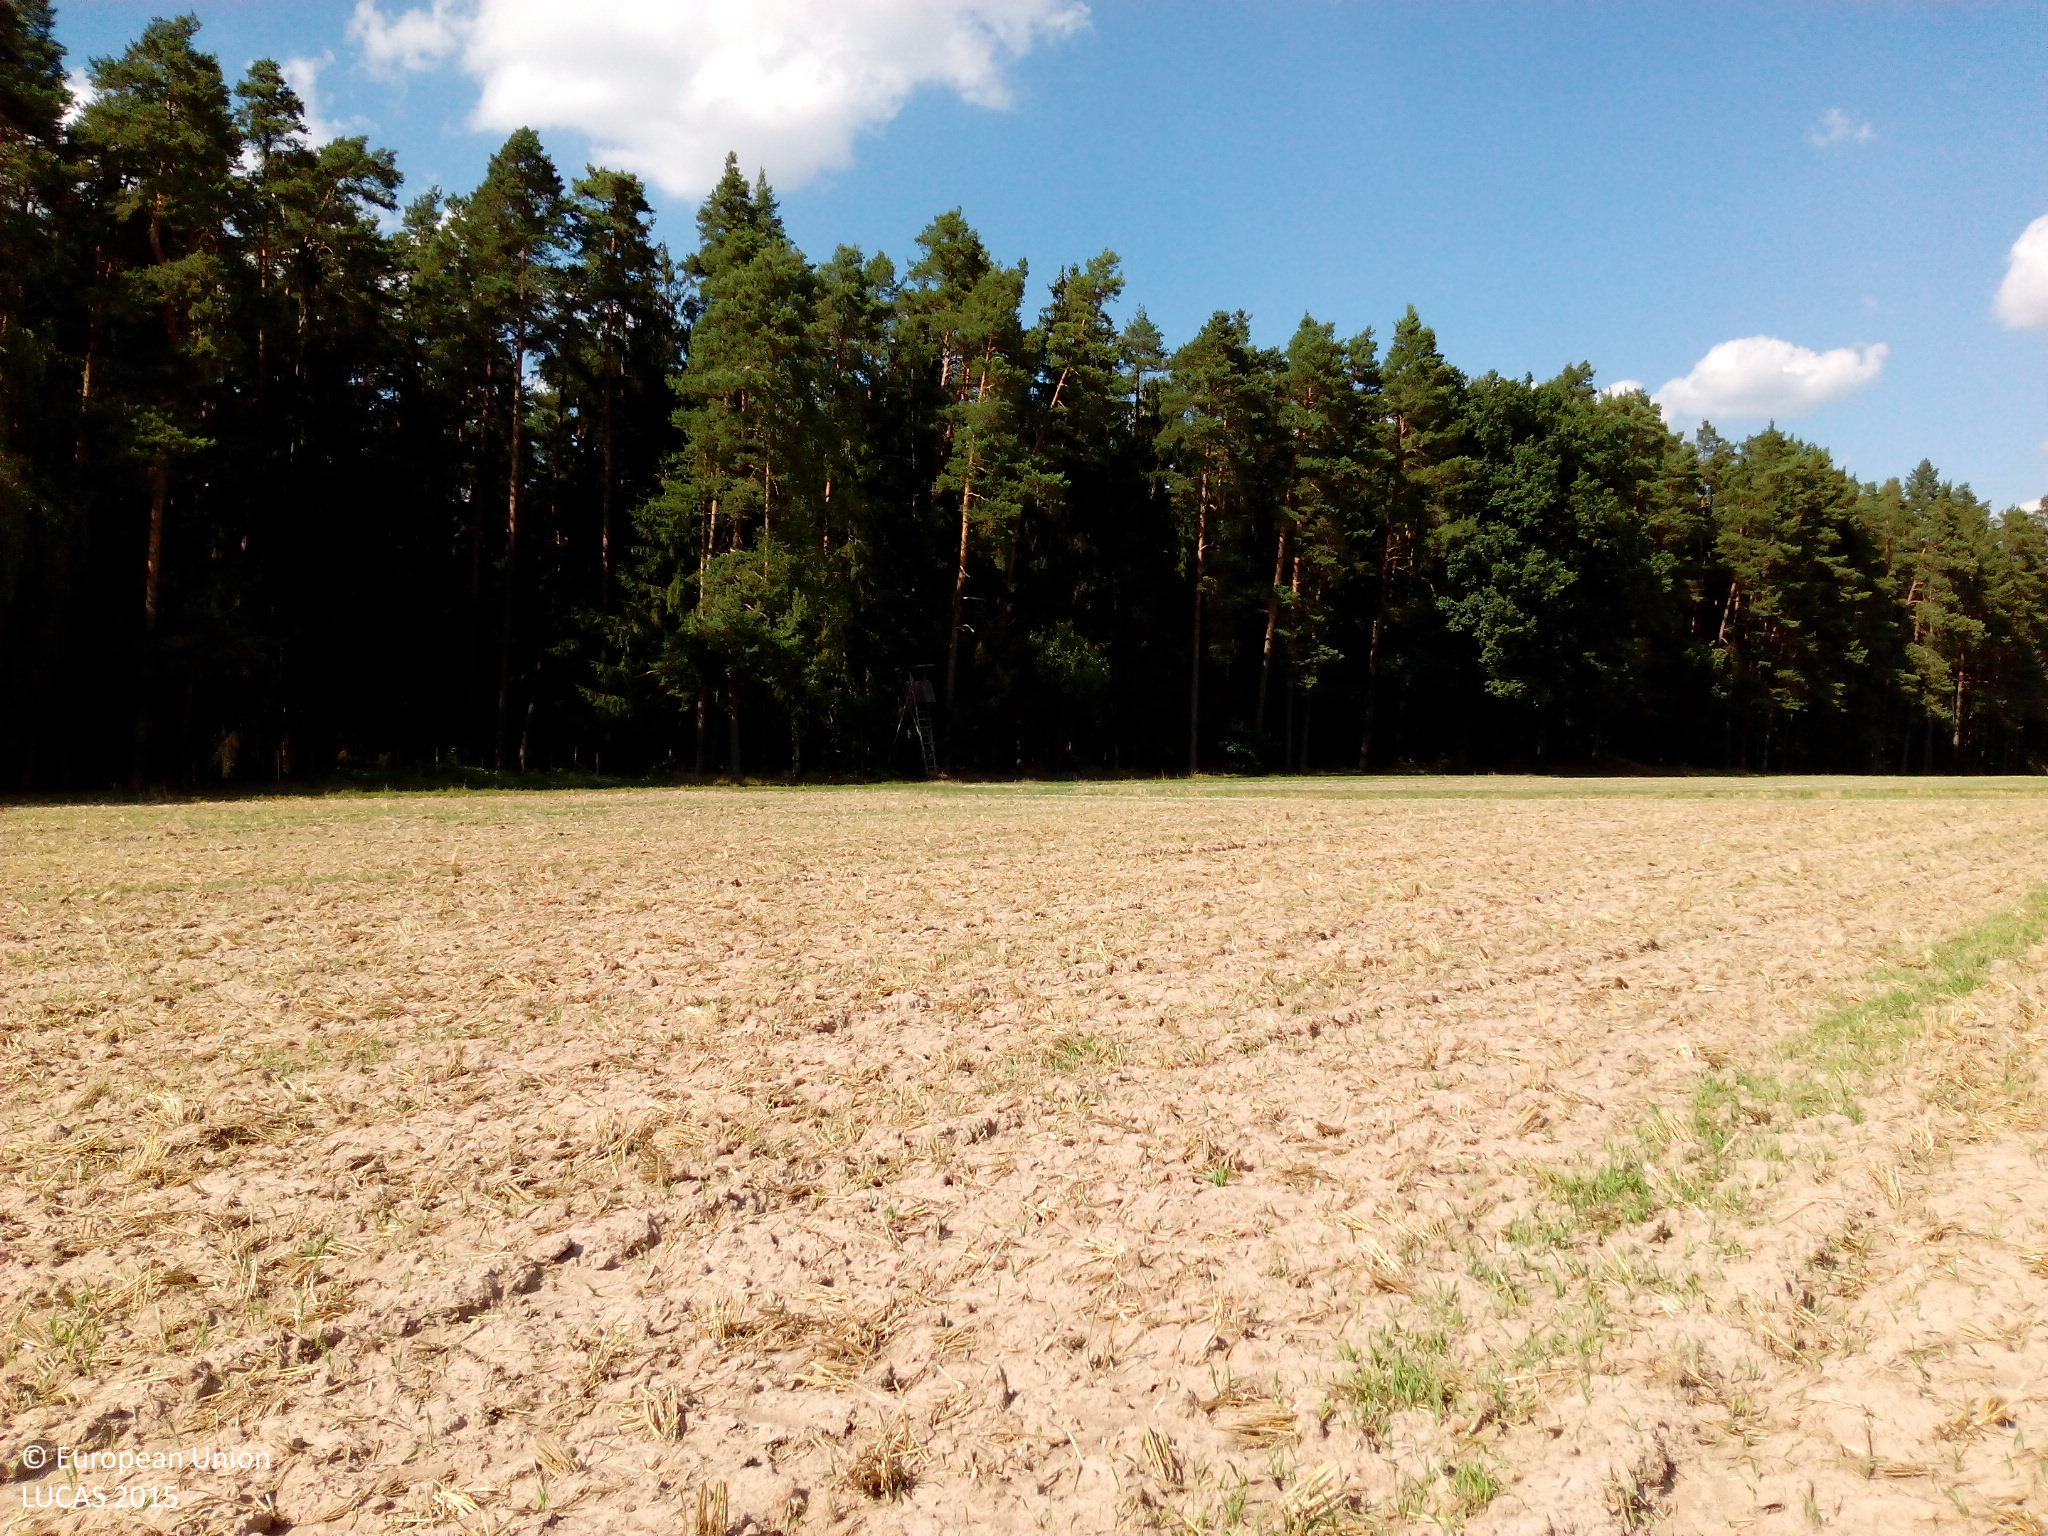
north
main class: Cropland
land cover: Common wheat
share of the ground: < 10 %
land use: Agriculture (excluding fallow land and kitchen gardens)
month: August
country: DE
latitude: 49.0147
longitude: 10.3143
